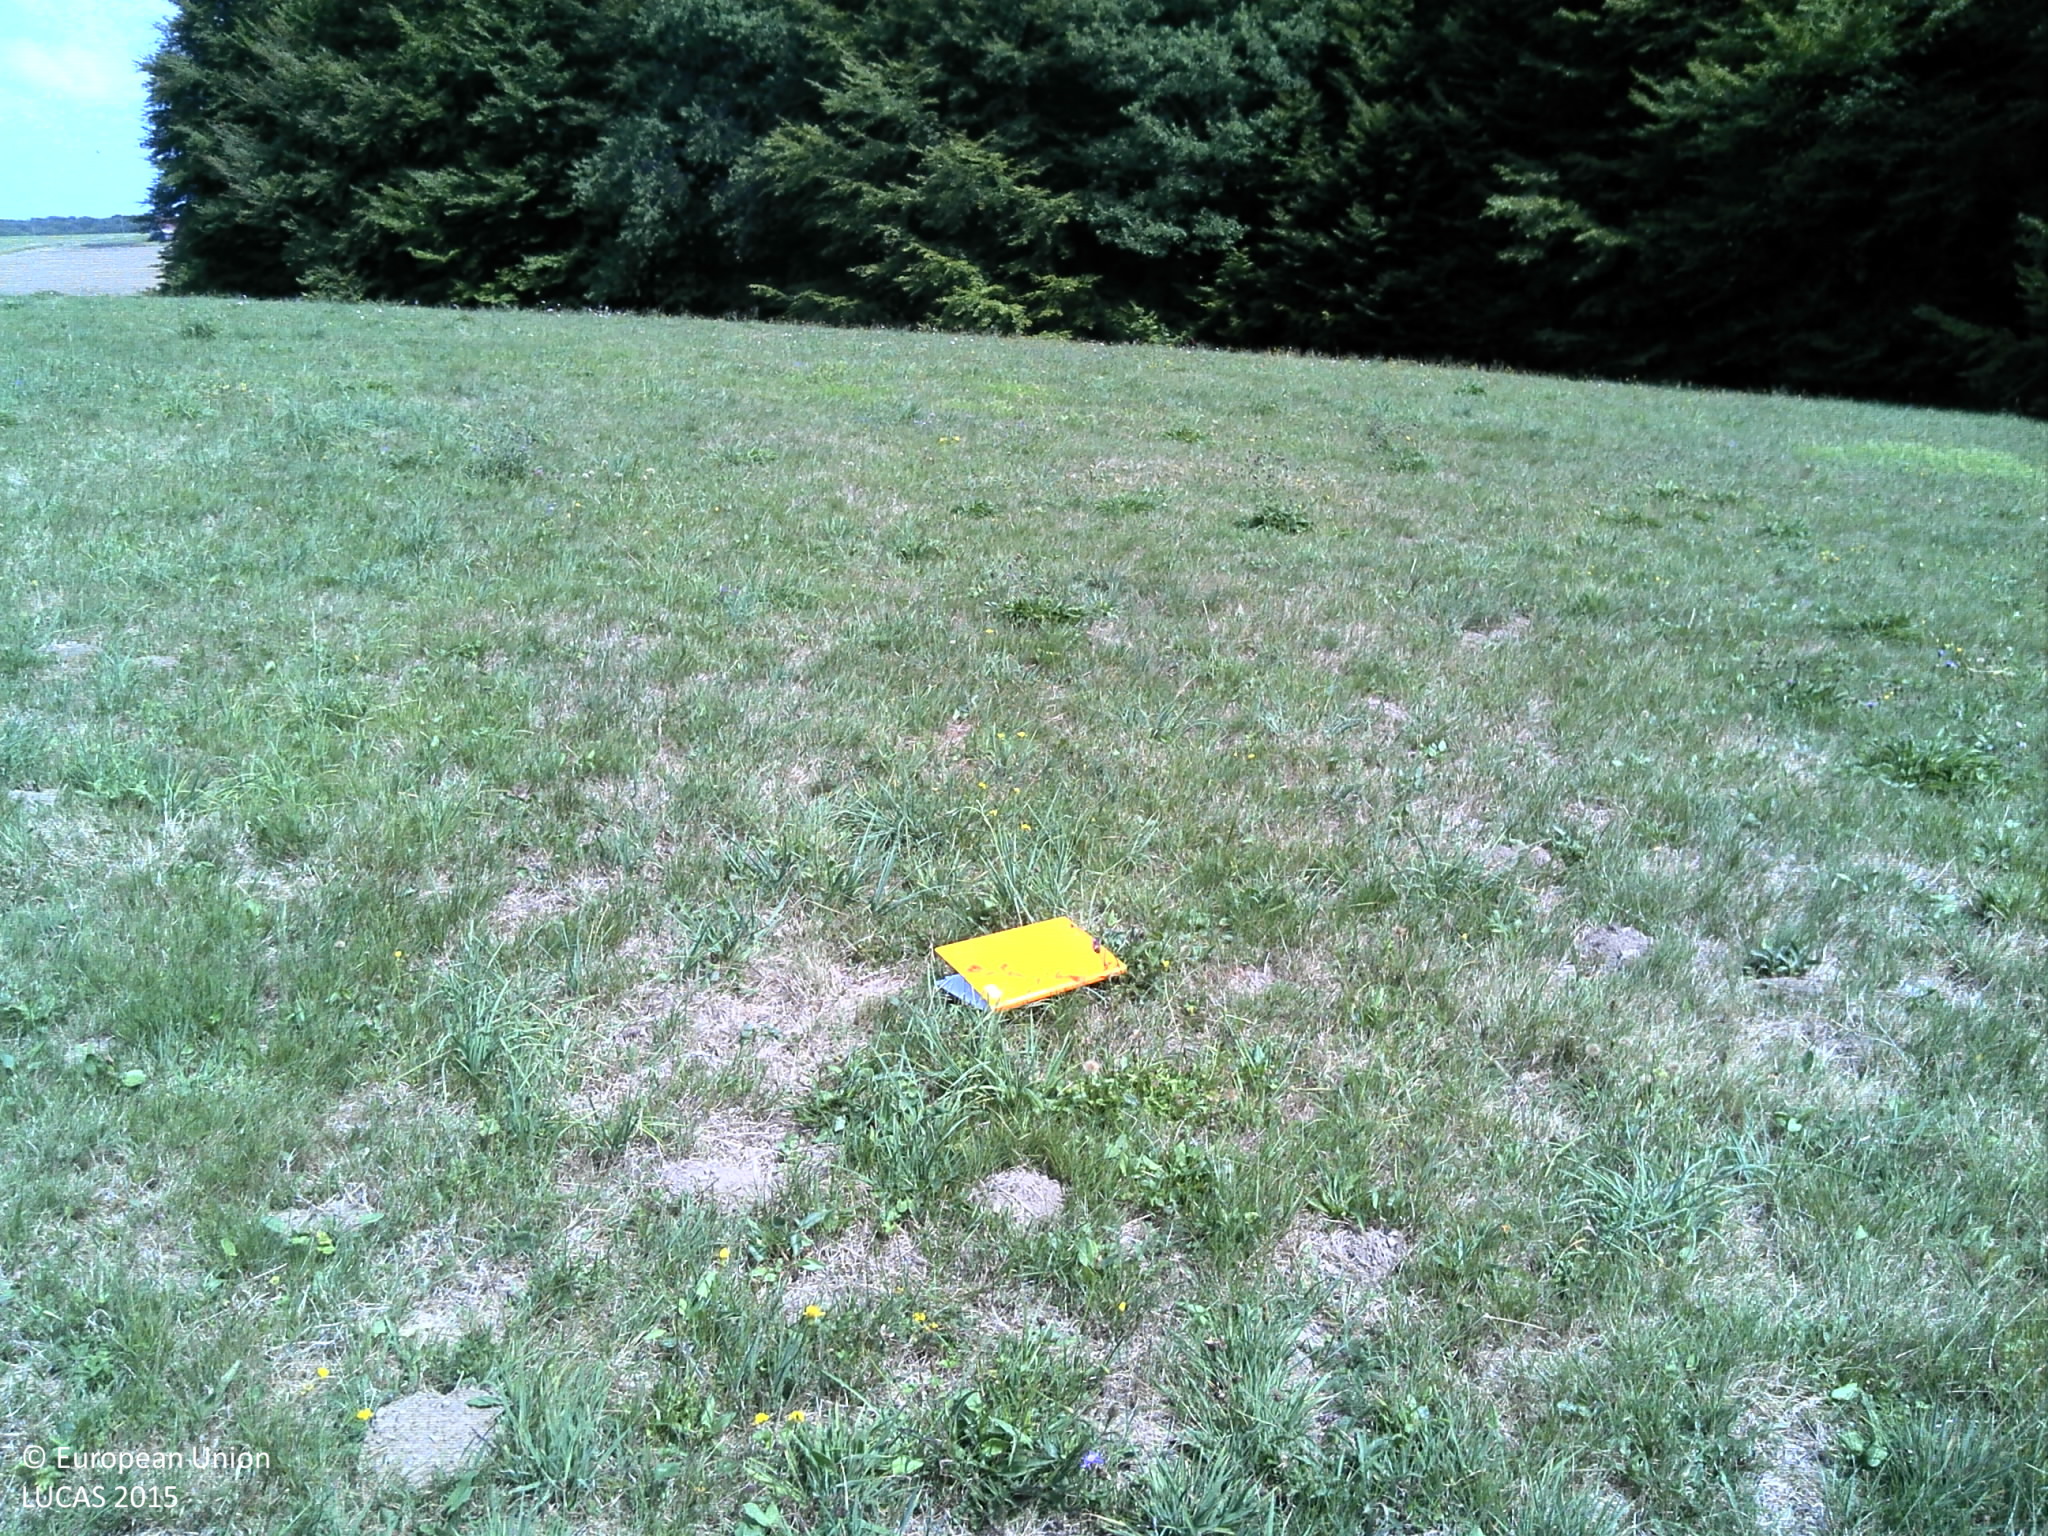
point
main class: Grassland
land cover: Grassland without tree/shrub cover
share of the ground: > 75 %
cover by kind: herbaceous plants 100 %
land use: Agriculture (excluding fallow land and kitchen gardens)
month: August
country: FR
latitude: 48.0008
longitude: 6.3419
